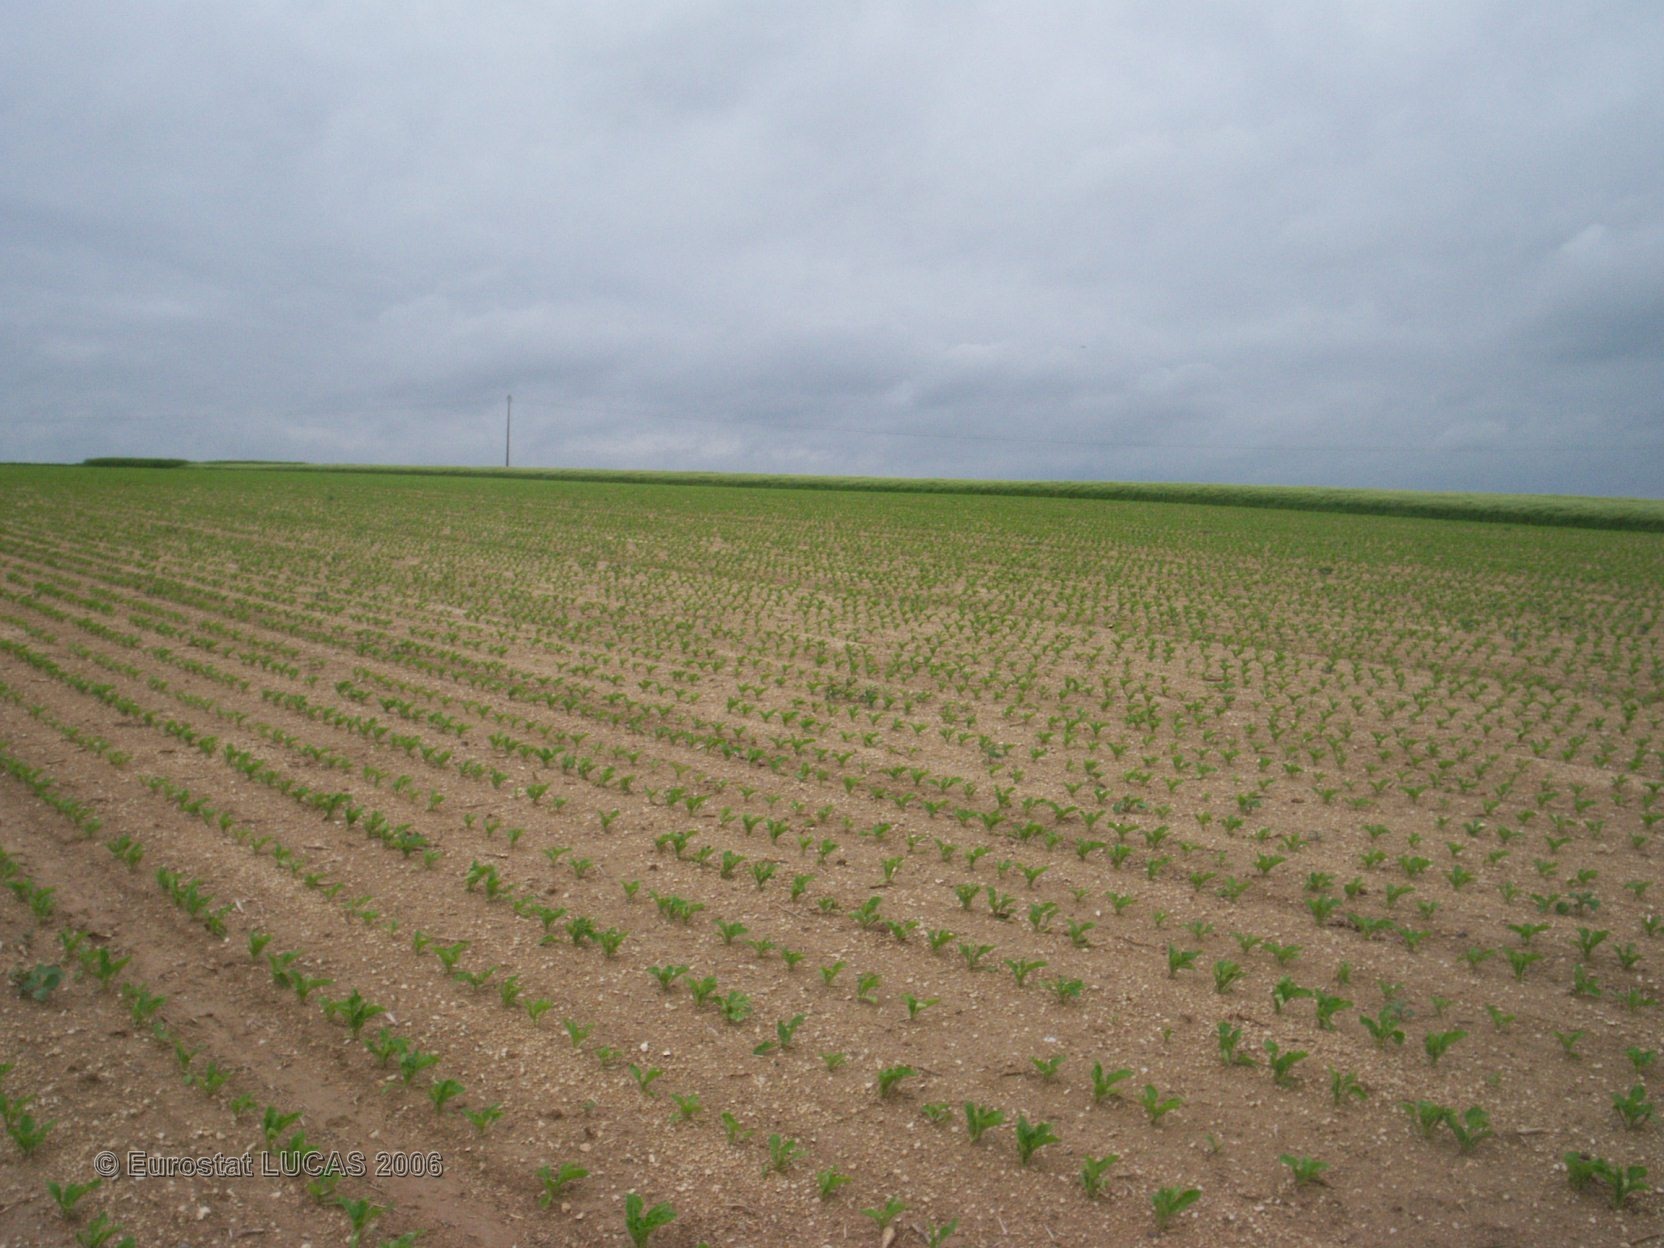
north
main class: Cropland
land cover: Sugar beet
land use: Agriculture (excluding fallow land and kitchen gardens)
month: May
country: FR
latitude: 49.4122
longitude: 4.3309
